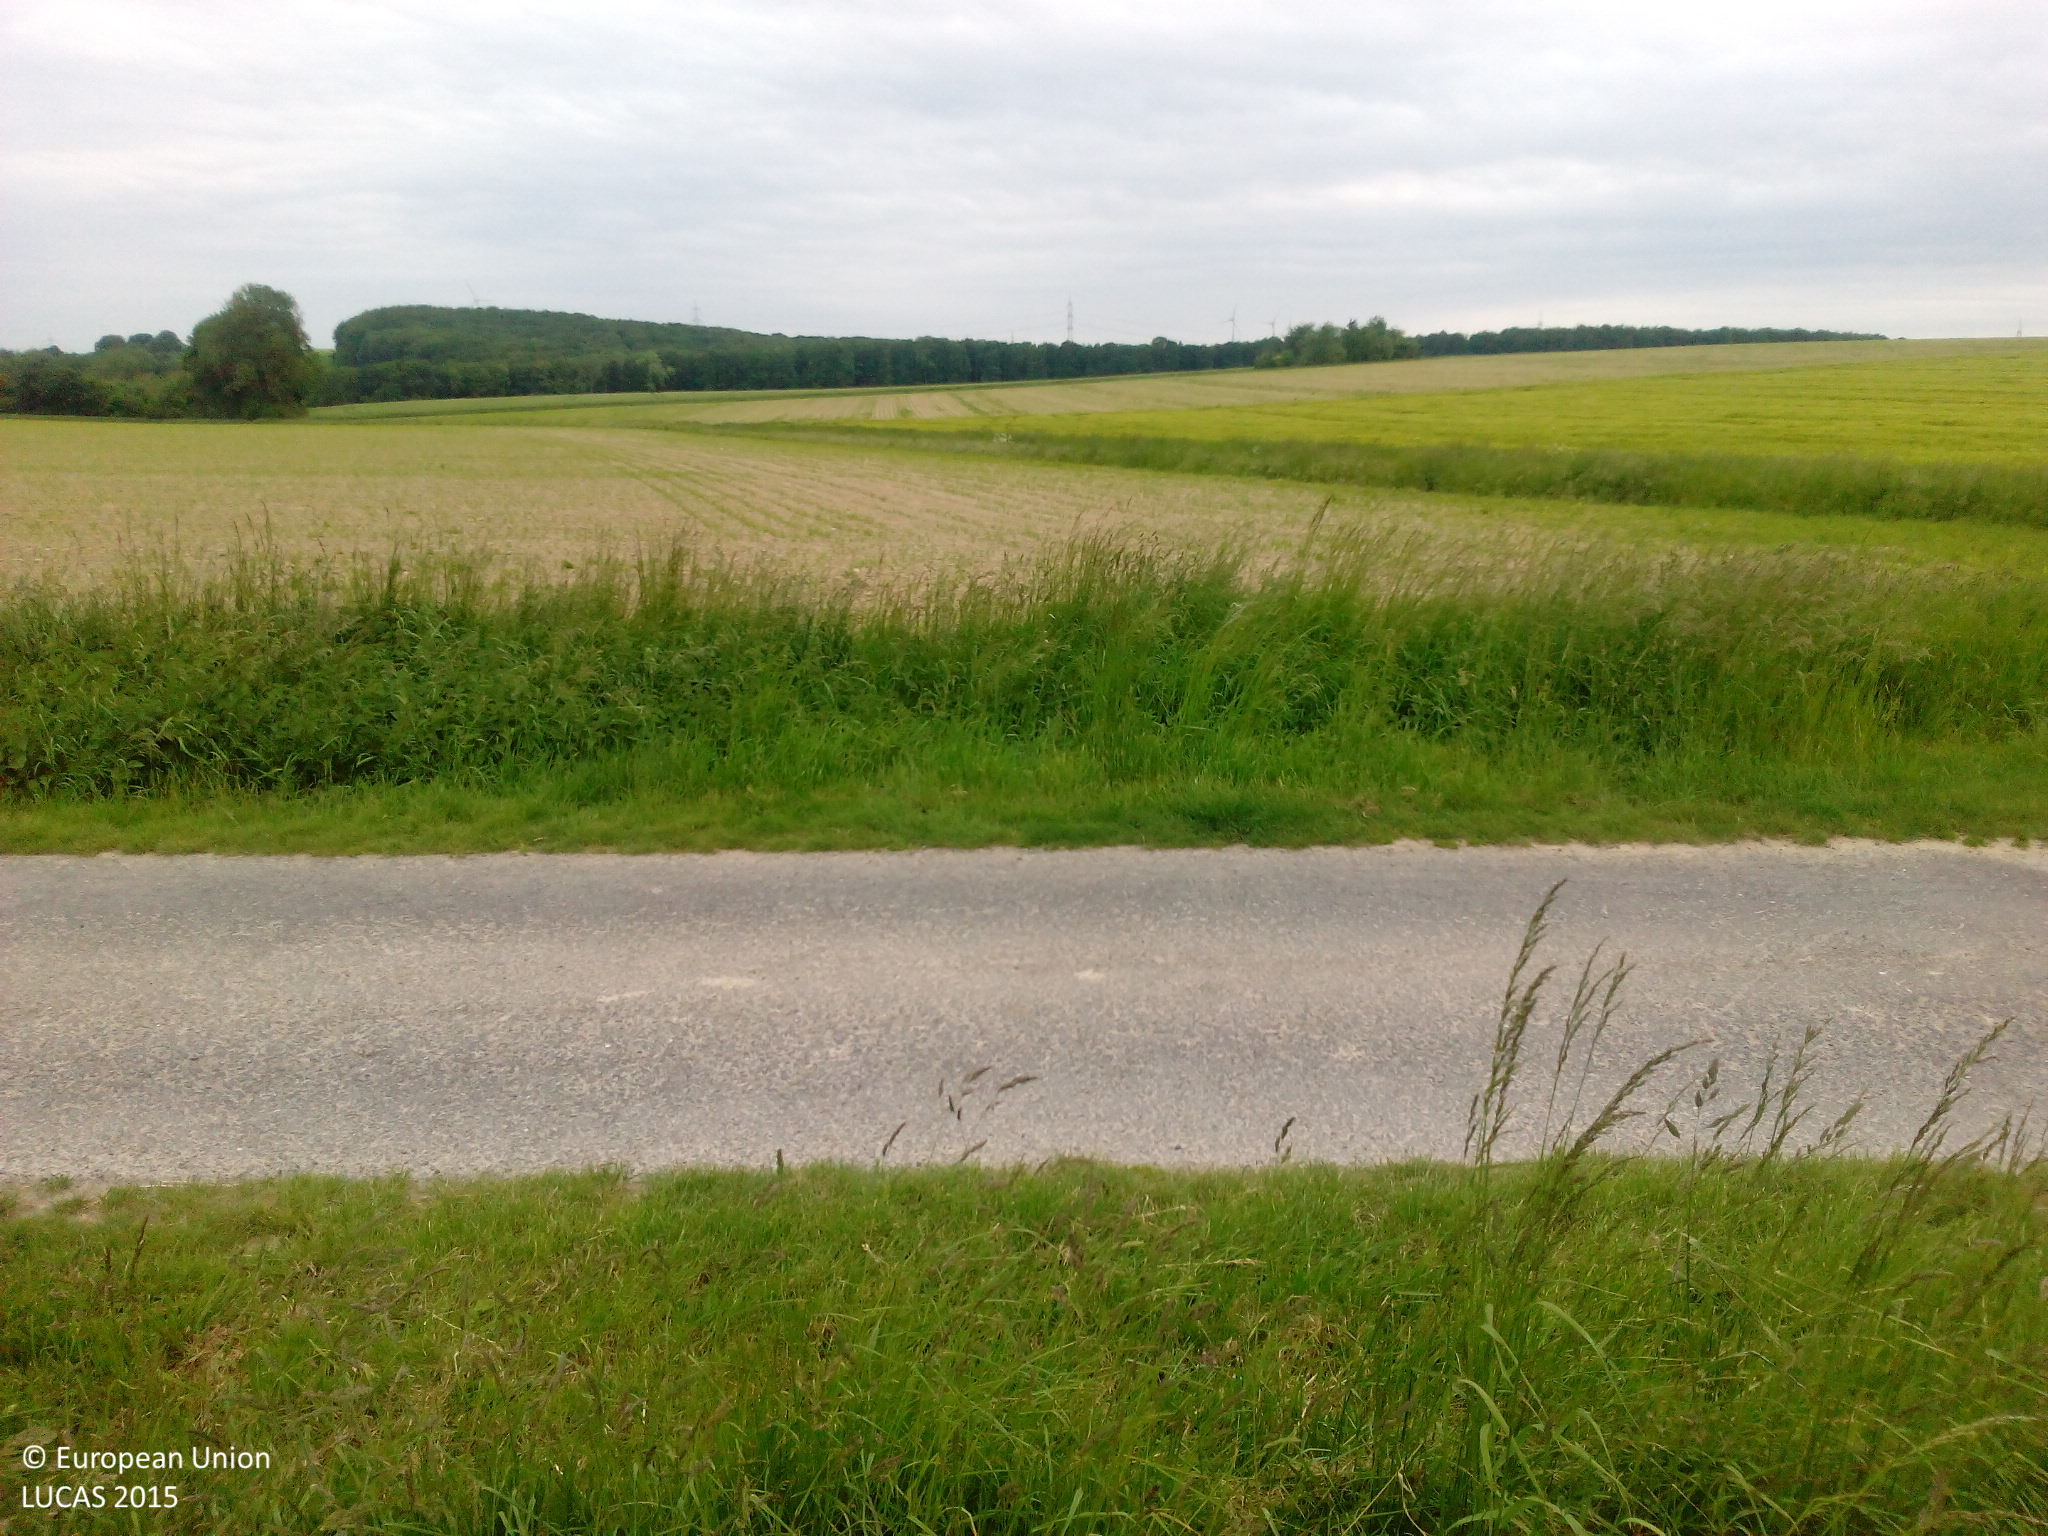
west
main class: Cropland
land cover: Barley
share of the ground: > 75 %
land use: Agriculture (excluding fallow land and kitchen gardens)
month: June
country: DE
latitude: 51.5155
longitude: 7.9973
